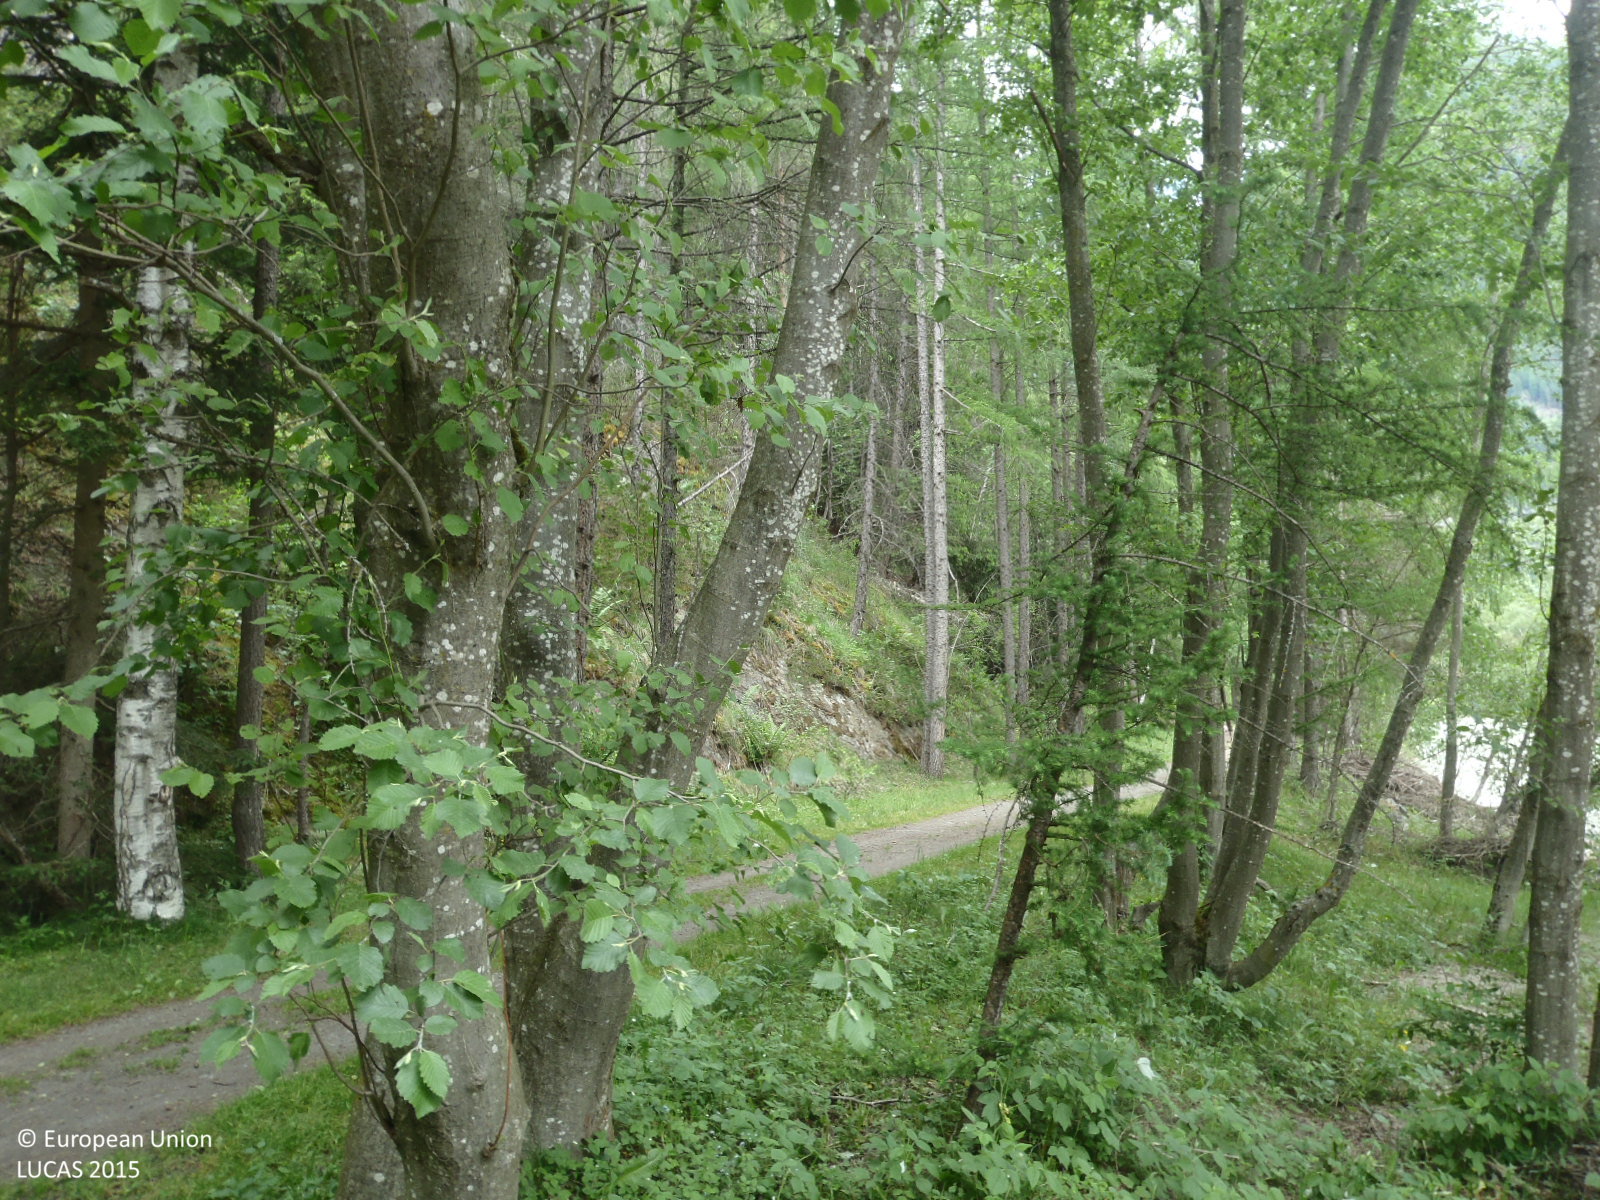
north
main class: Woodland
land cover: Pine dominated coniferous woodland
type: alpine coniferous forest
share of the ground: > 75 %
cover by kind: coniferous forest trees 85 %, shrubs 10 %, consolidated bare surface 5 %
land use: Semi-natural and natural areas not in use
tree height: > 5 m
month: June
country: AT
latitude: 47.0673
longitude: 10.9603
